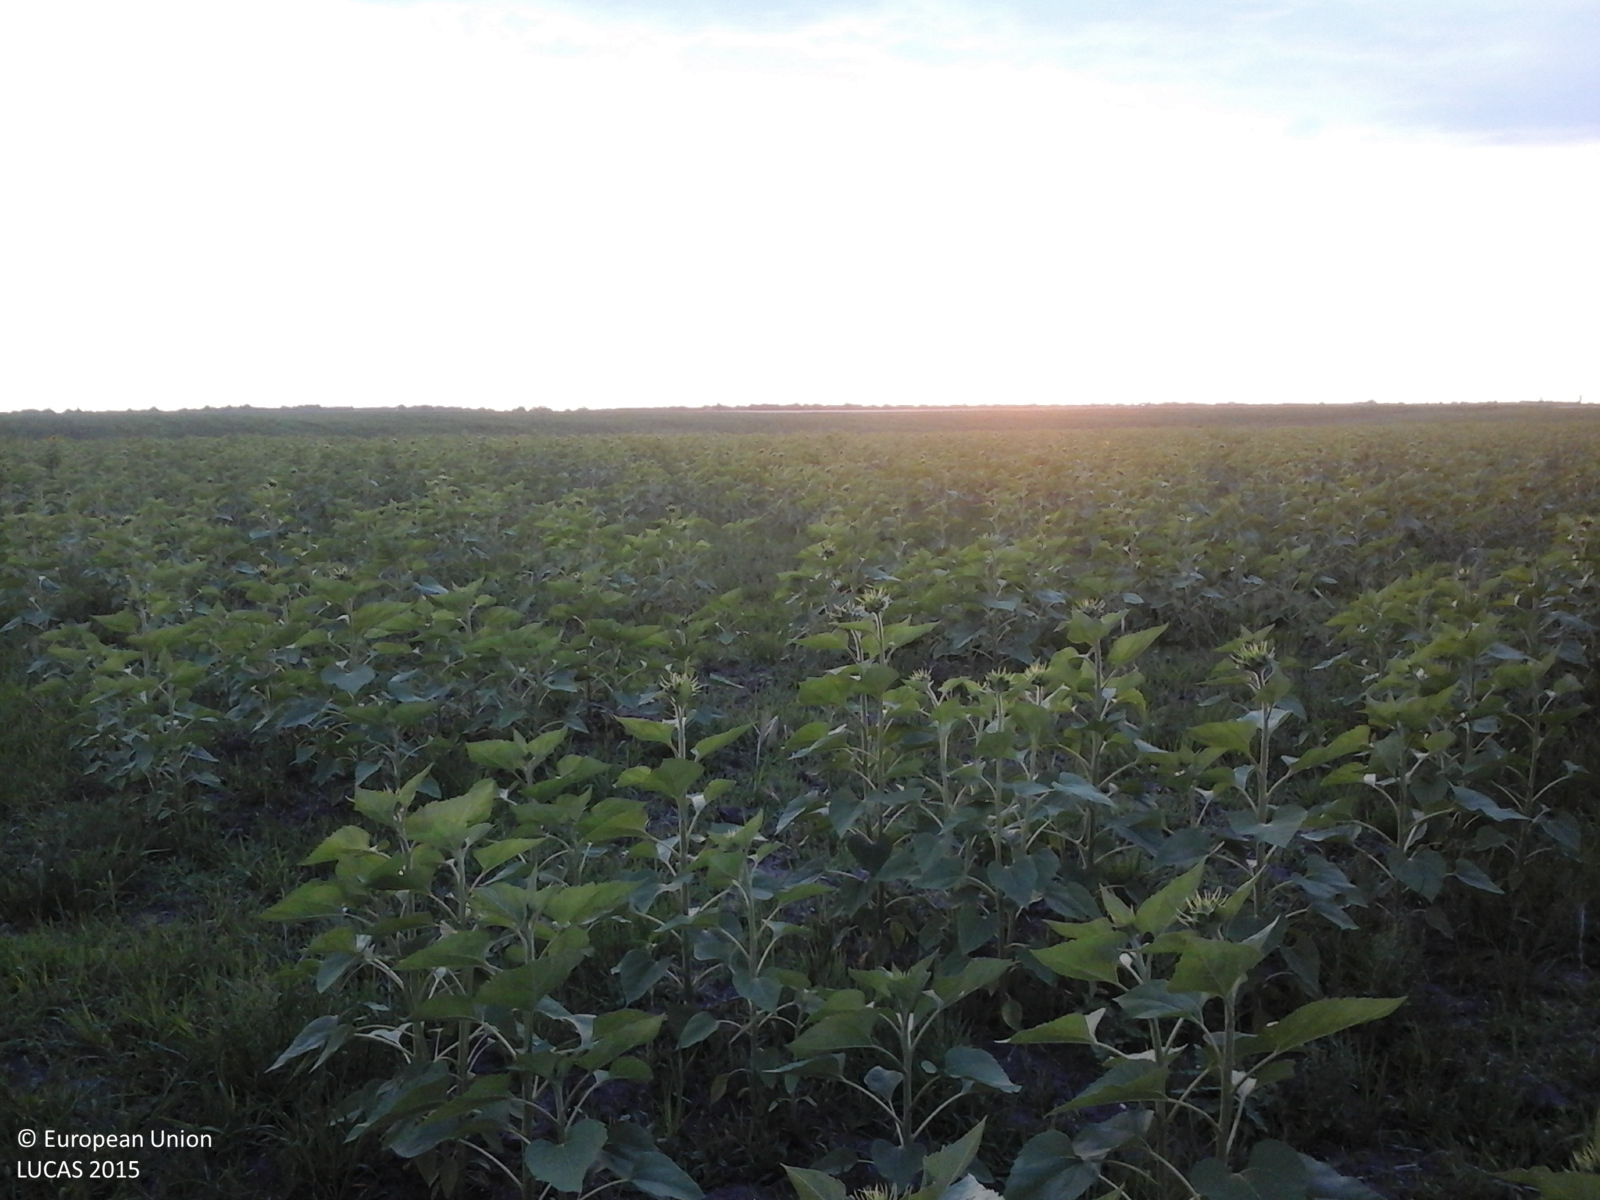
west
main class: Cropland
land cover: Sunflower
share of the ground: 50 - 75 %
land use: Agriculture (excluding fallow land and kitchen gardens)
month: July
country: RO
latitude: 44.3317
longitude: 24.8880
